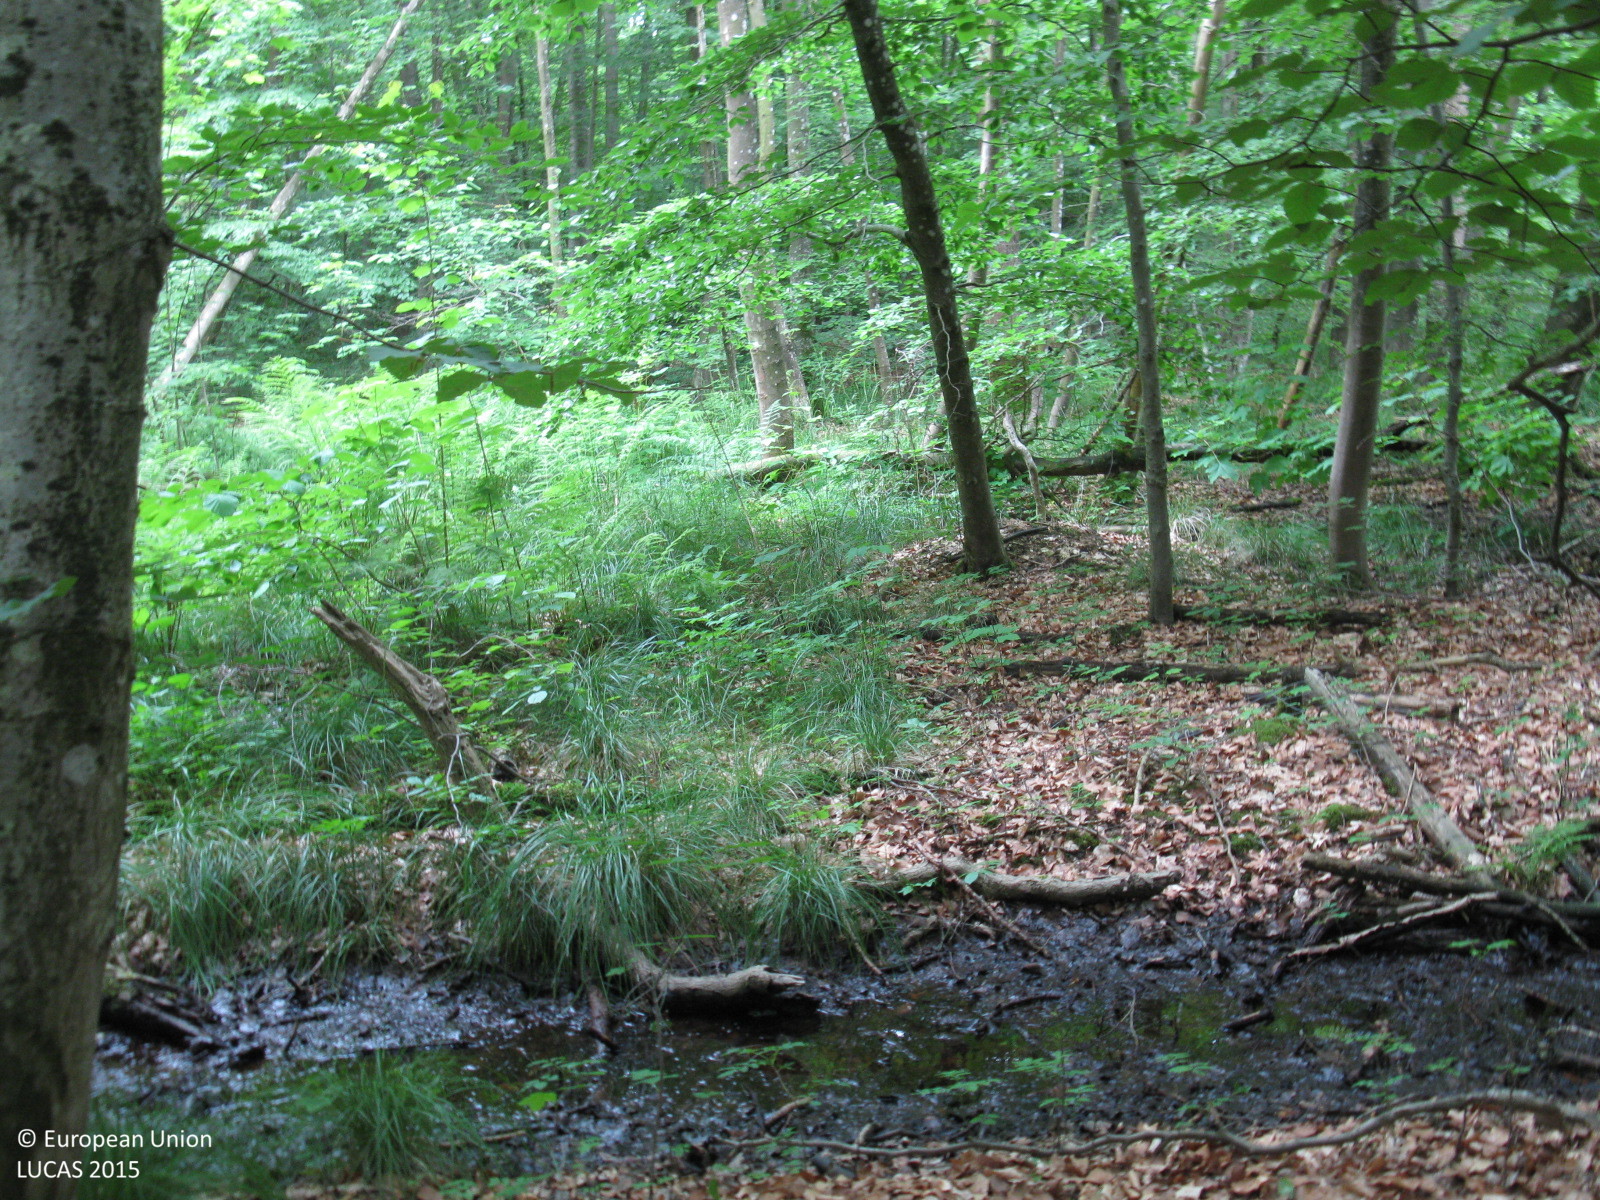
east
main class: Woodland
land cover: Broadleaved woodland
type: beech forest
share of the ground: > 75 %
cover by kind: broadleaved forest trees 100 %
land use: Forestry
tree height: > 5 m
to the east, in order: Broadleaved woodland; Ditches and canals; Broadleaved woodland; Tracks; Broadleaved woodland; Tracks; Broadleaved woodland
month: June
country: DE
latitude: 53.5276
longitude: 7.9039
